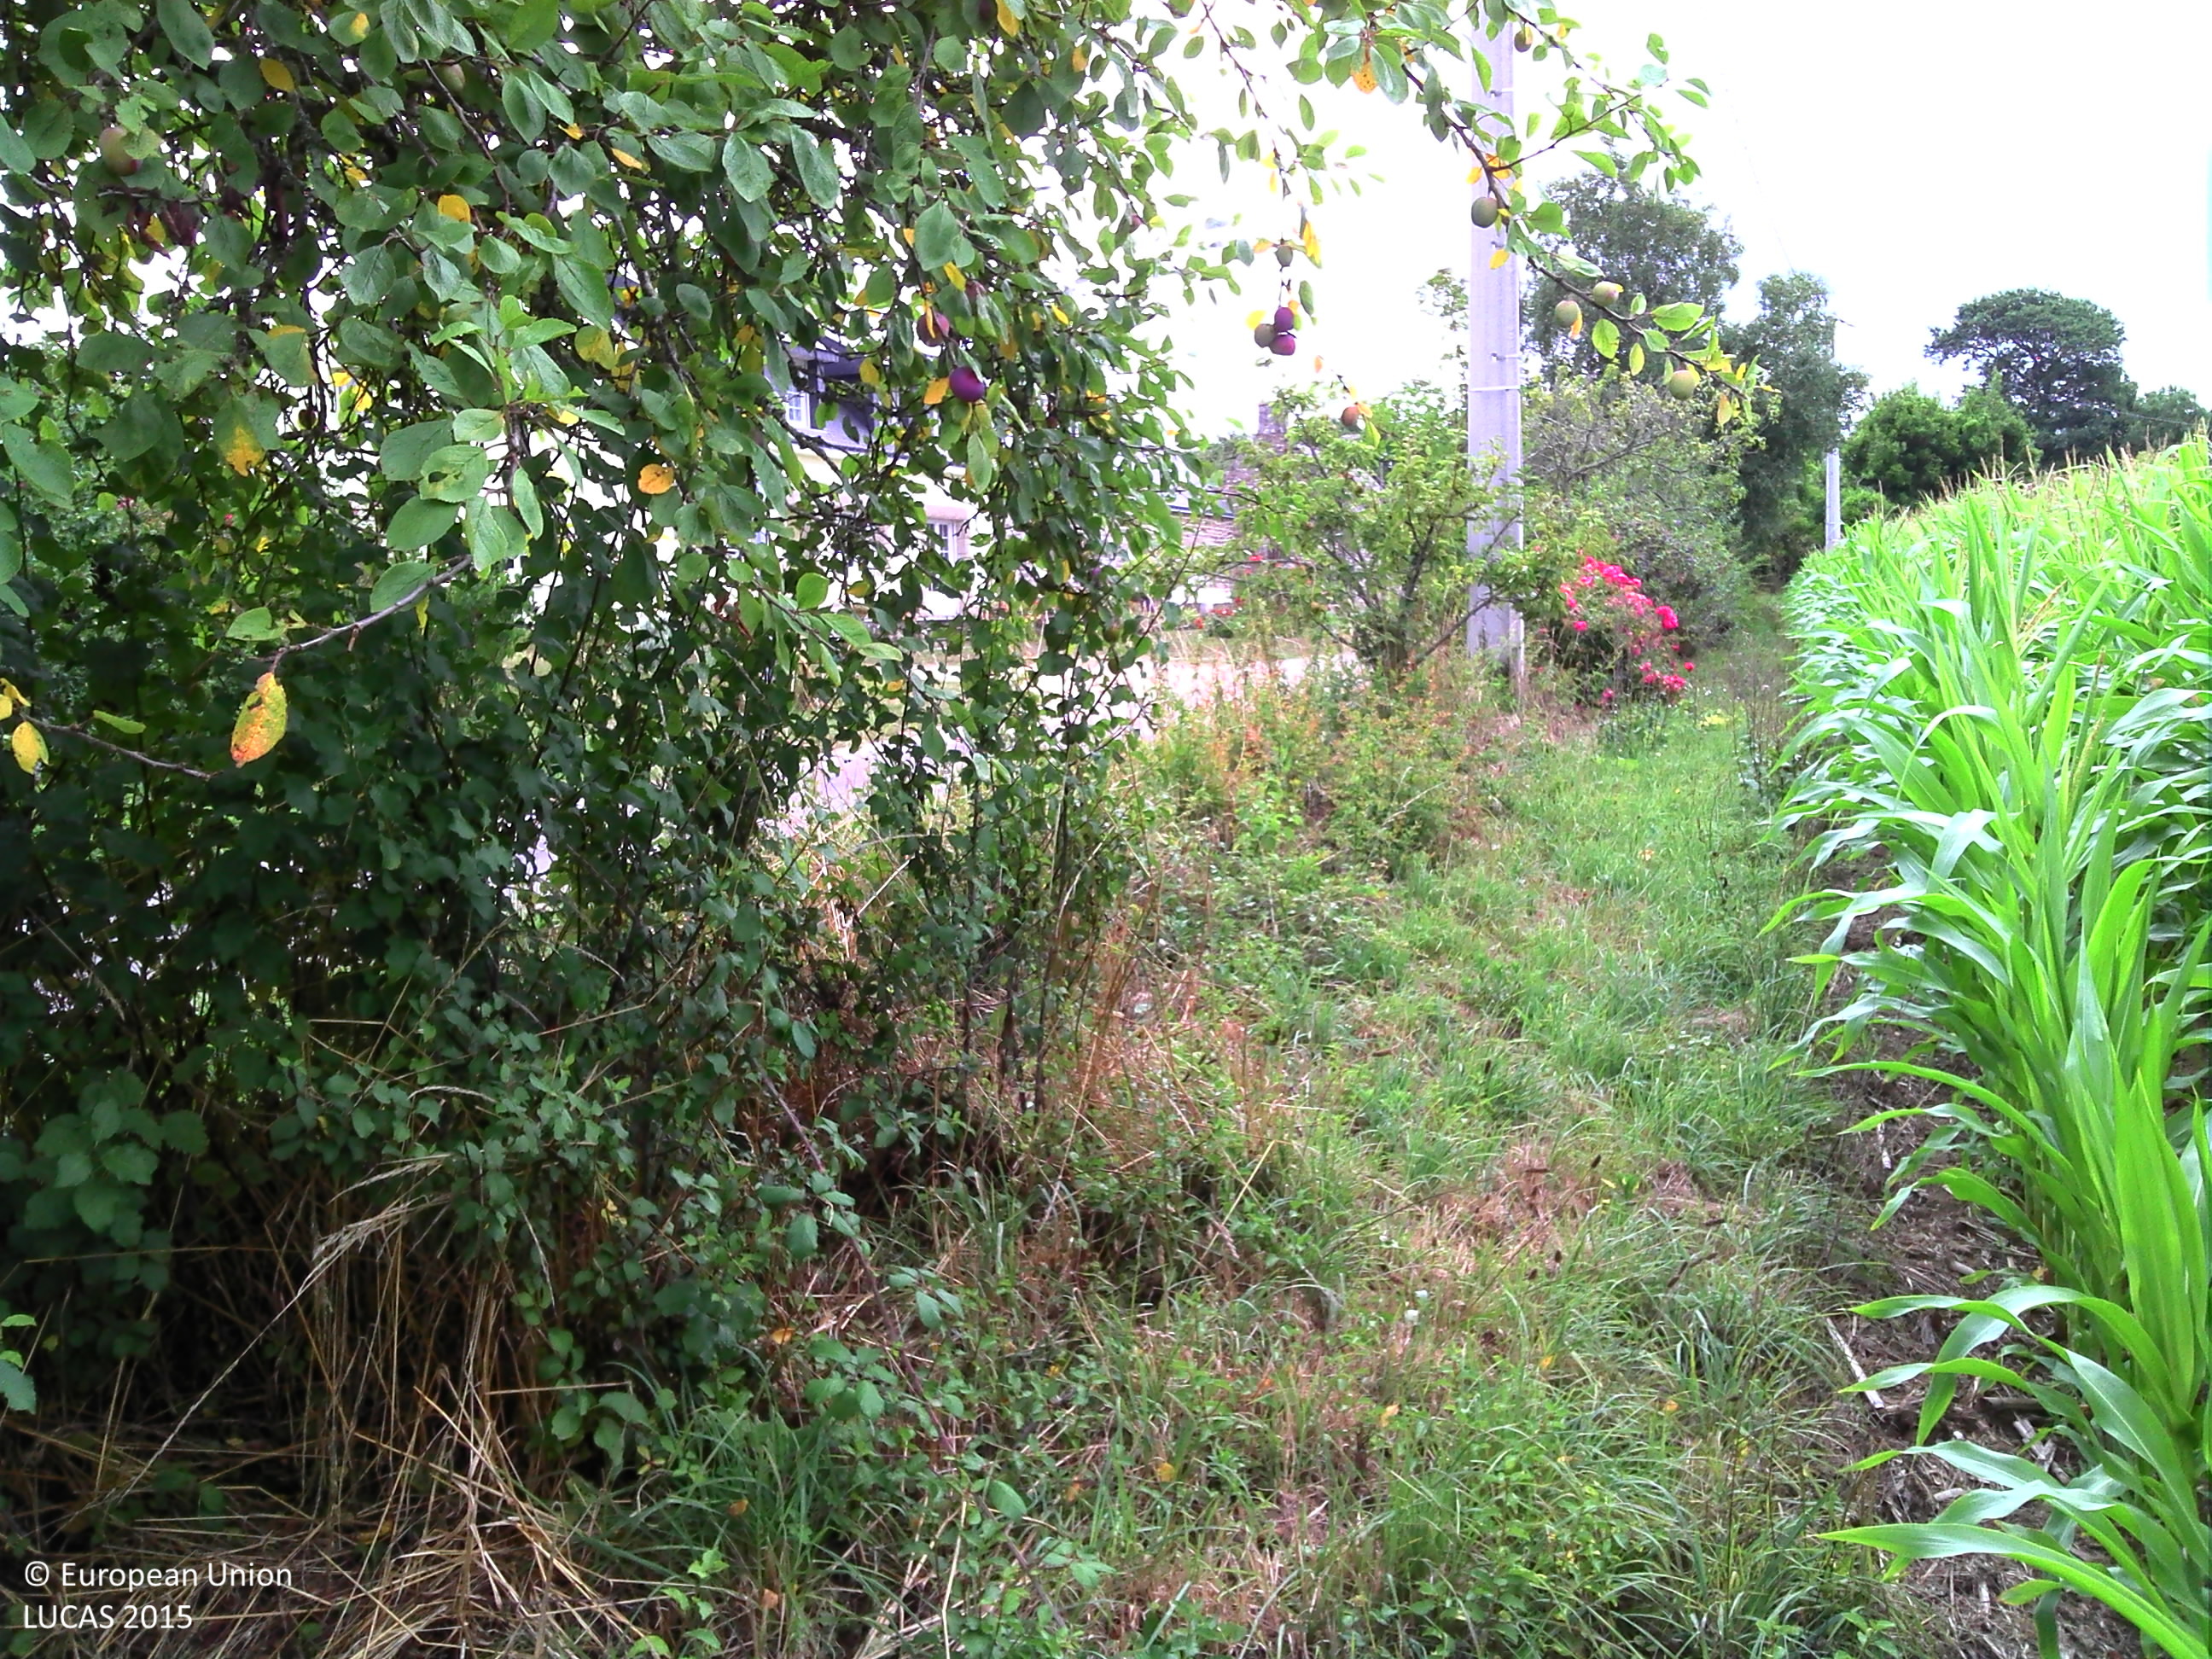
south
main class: Cropland
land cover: Maize
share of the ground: > 75 %
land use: Agriculture (excluding fallow land and kitchen gardens)
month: July
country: FR
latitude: 47.6543
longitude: -2.9668
